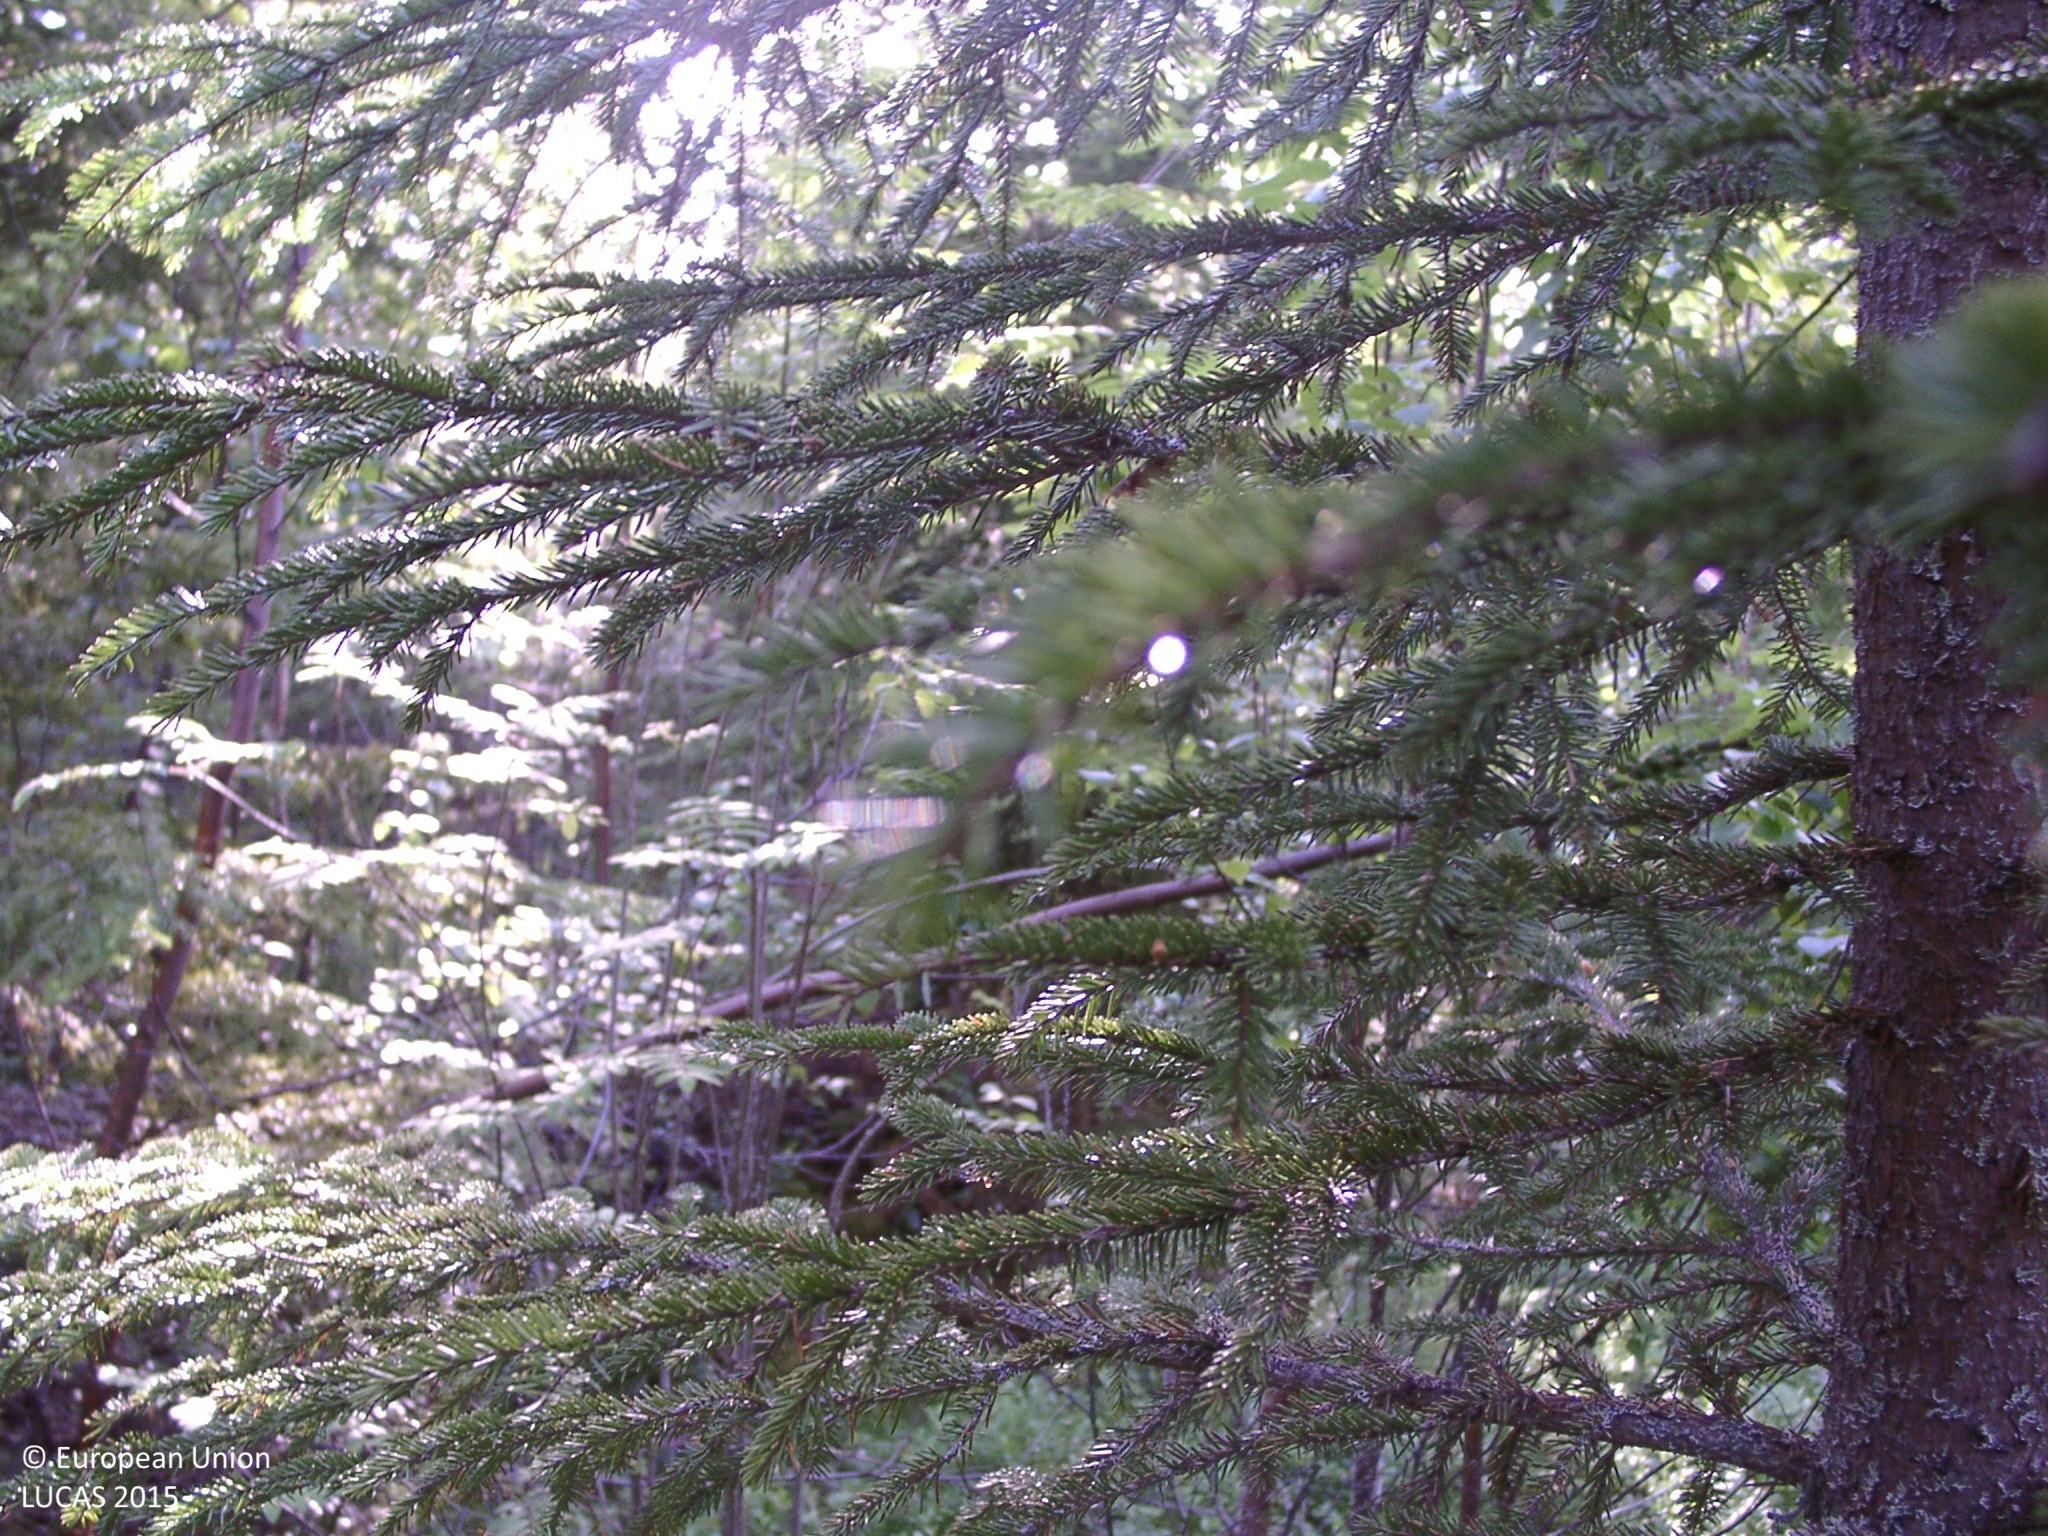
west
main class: Woodland
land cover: Spruce dominated mixed woodland
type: boreal forest
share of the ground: > 75 %
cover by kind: broadleaved forest trees 45 %, coniferous forest trees 40 %, shrubs 5 %, herbaceous plants 5 %, lichens and mosses 5 %
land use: Forestry
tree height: < 5 m
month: July
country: FI
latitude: 62.2456
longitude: 25.1392
